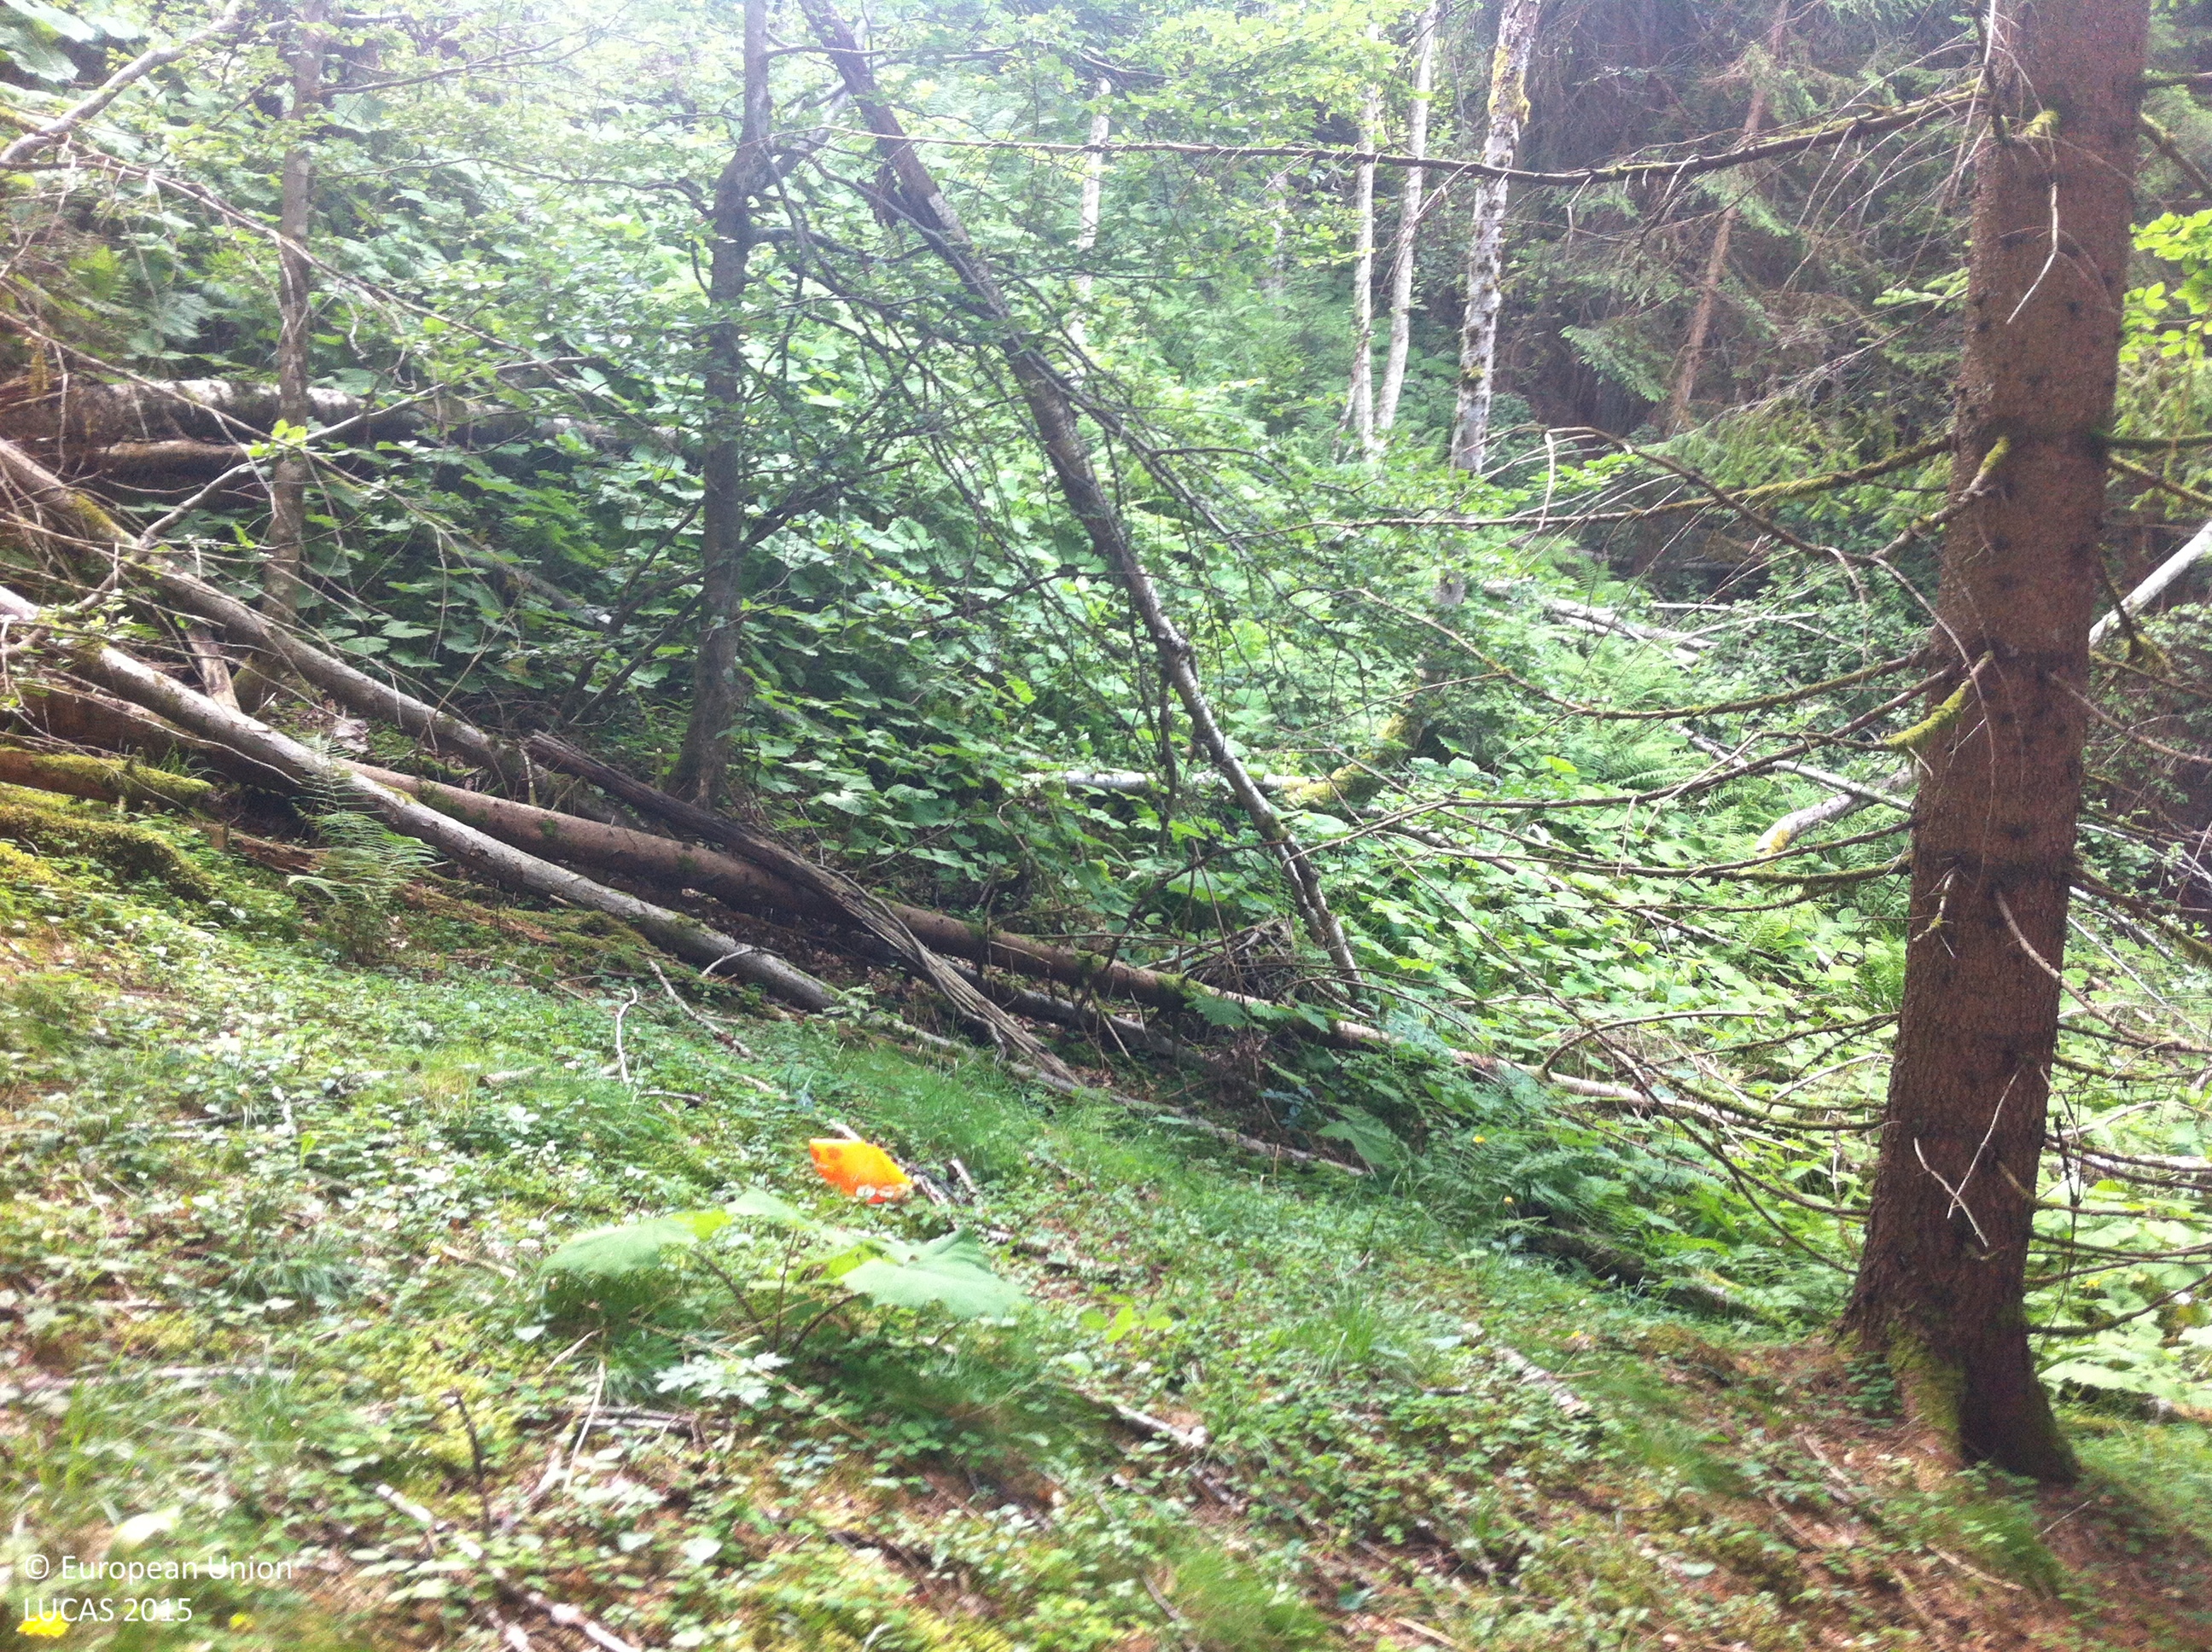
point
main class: Woodland
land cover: Spruce dominated coniferous woodland
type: alpine coniferous forest
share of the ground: > 75 %
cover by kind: coniferous forest trees 85 %, broadleaved forest trees 5 %, shrubs 5 %, herbaceous plants 5 %
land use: Forestry
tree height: > 5 m
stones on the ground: < 10 %
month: July
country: AT
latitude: 47.1255
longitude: 10.0395
